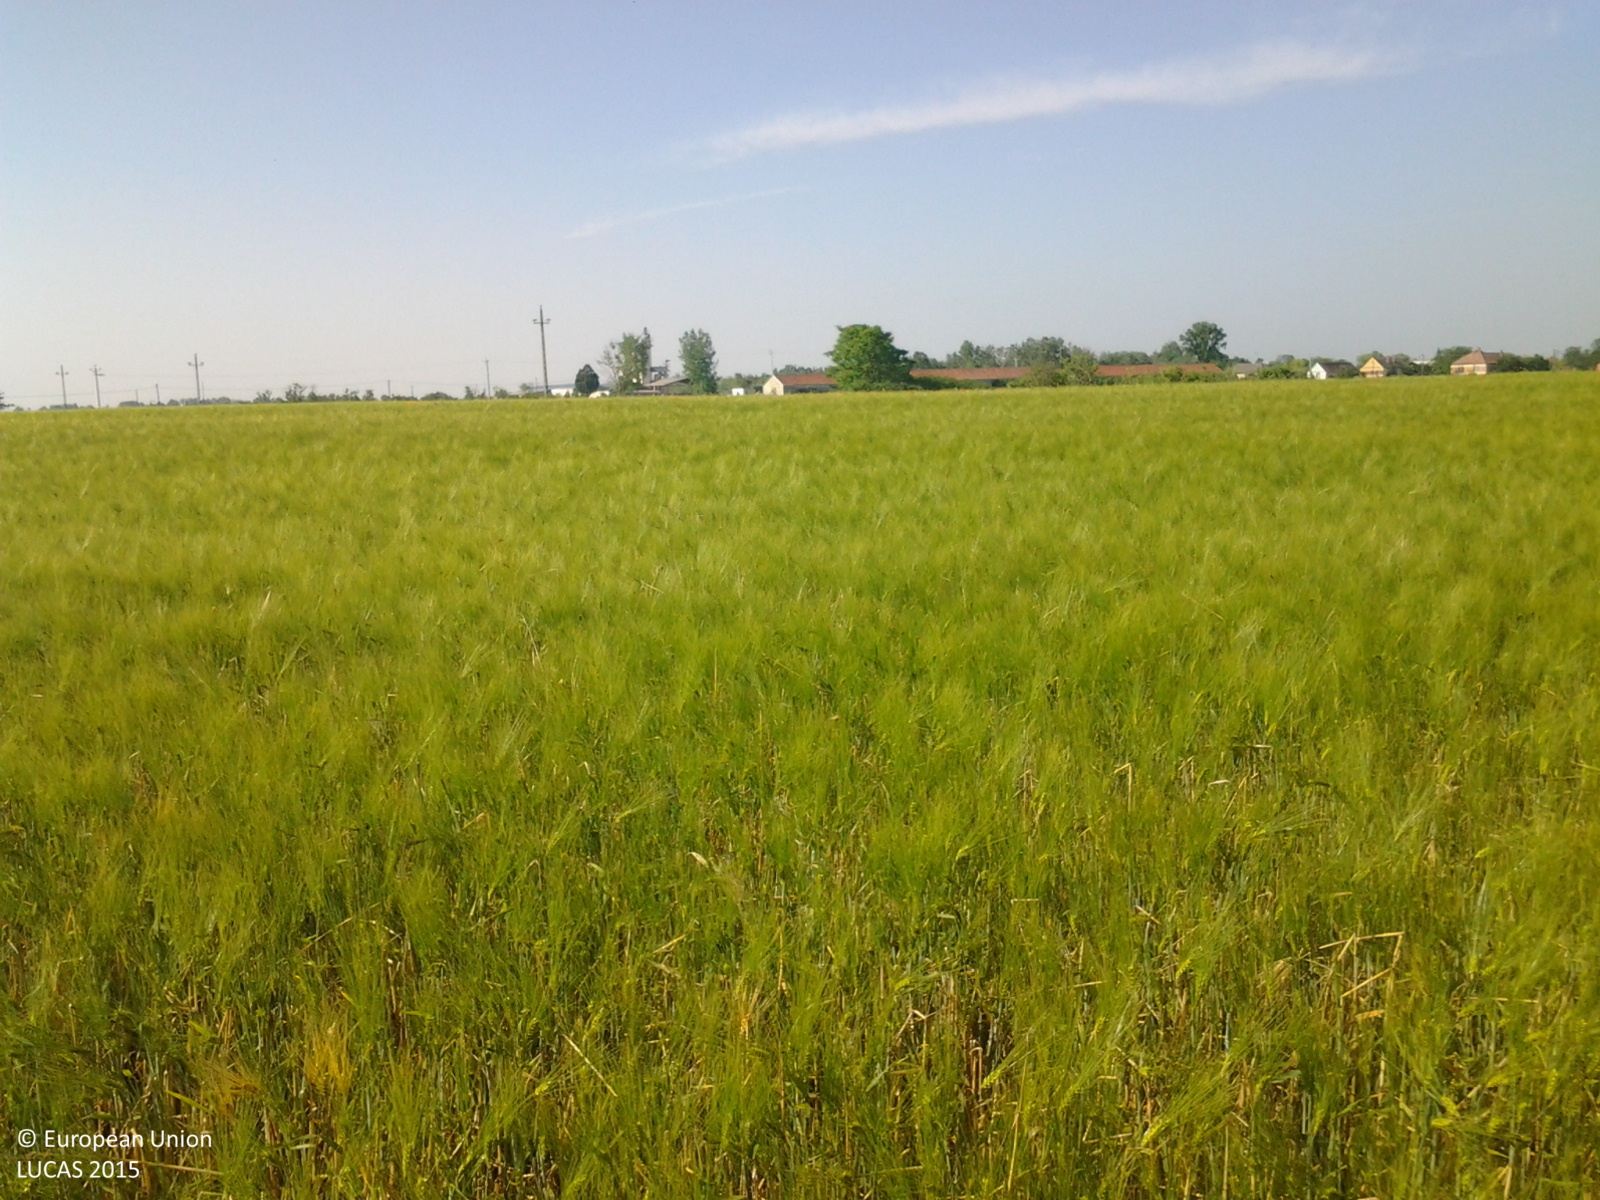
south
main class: Cropland
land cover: Barley
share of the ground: > 75 %
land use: Agriculture (excluding fallow land and kitchen gardens)
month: June
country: HU
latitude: 46.6001
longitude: 19.0610
